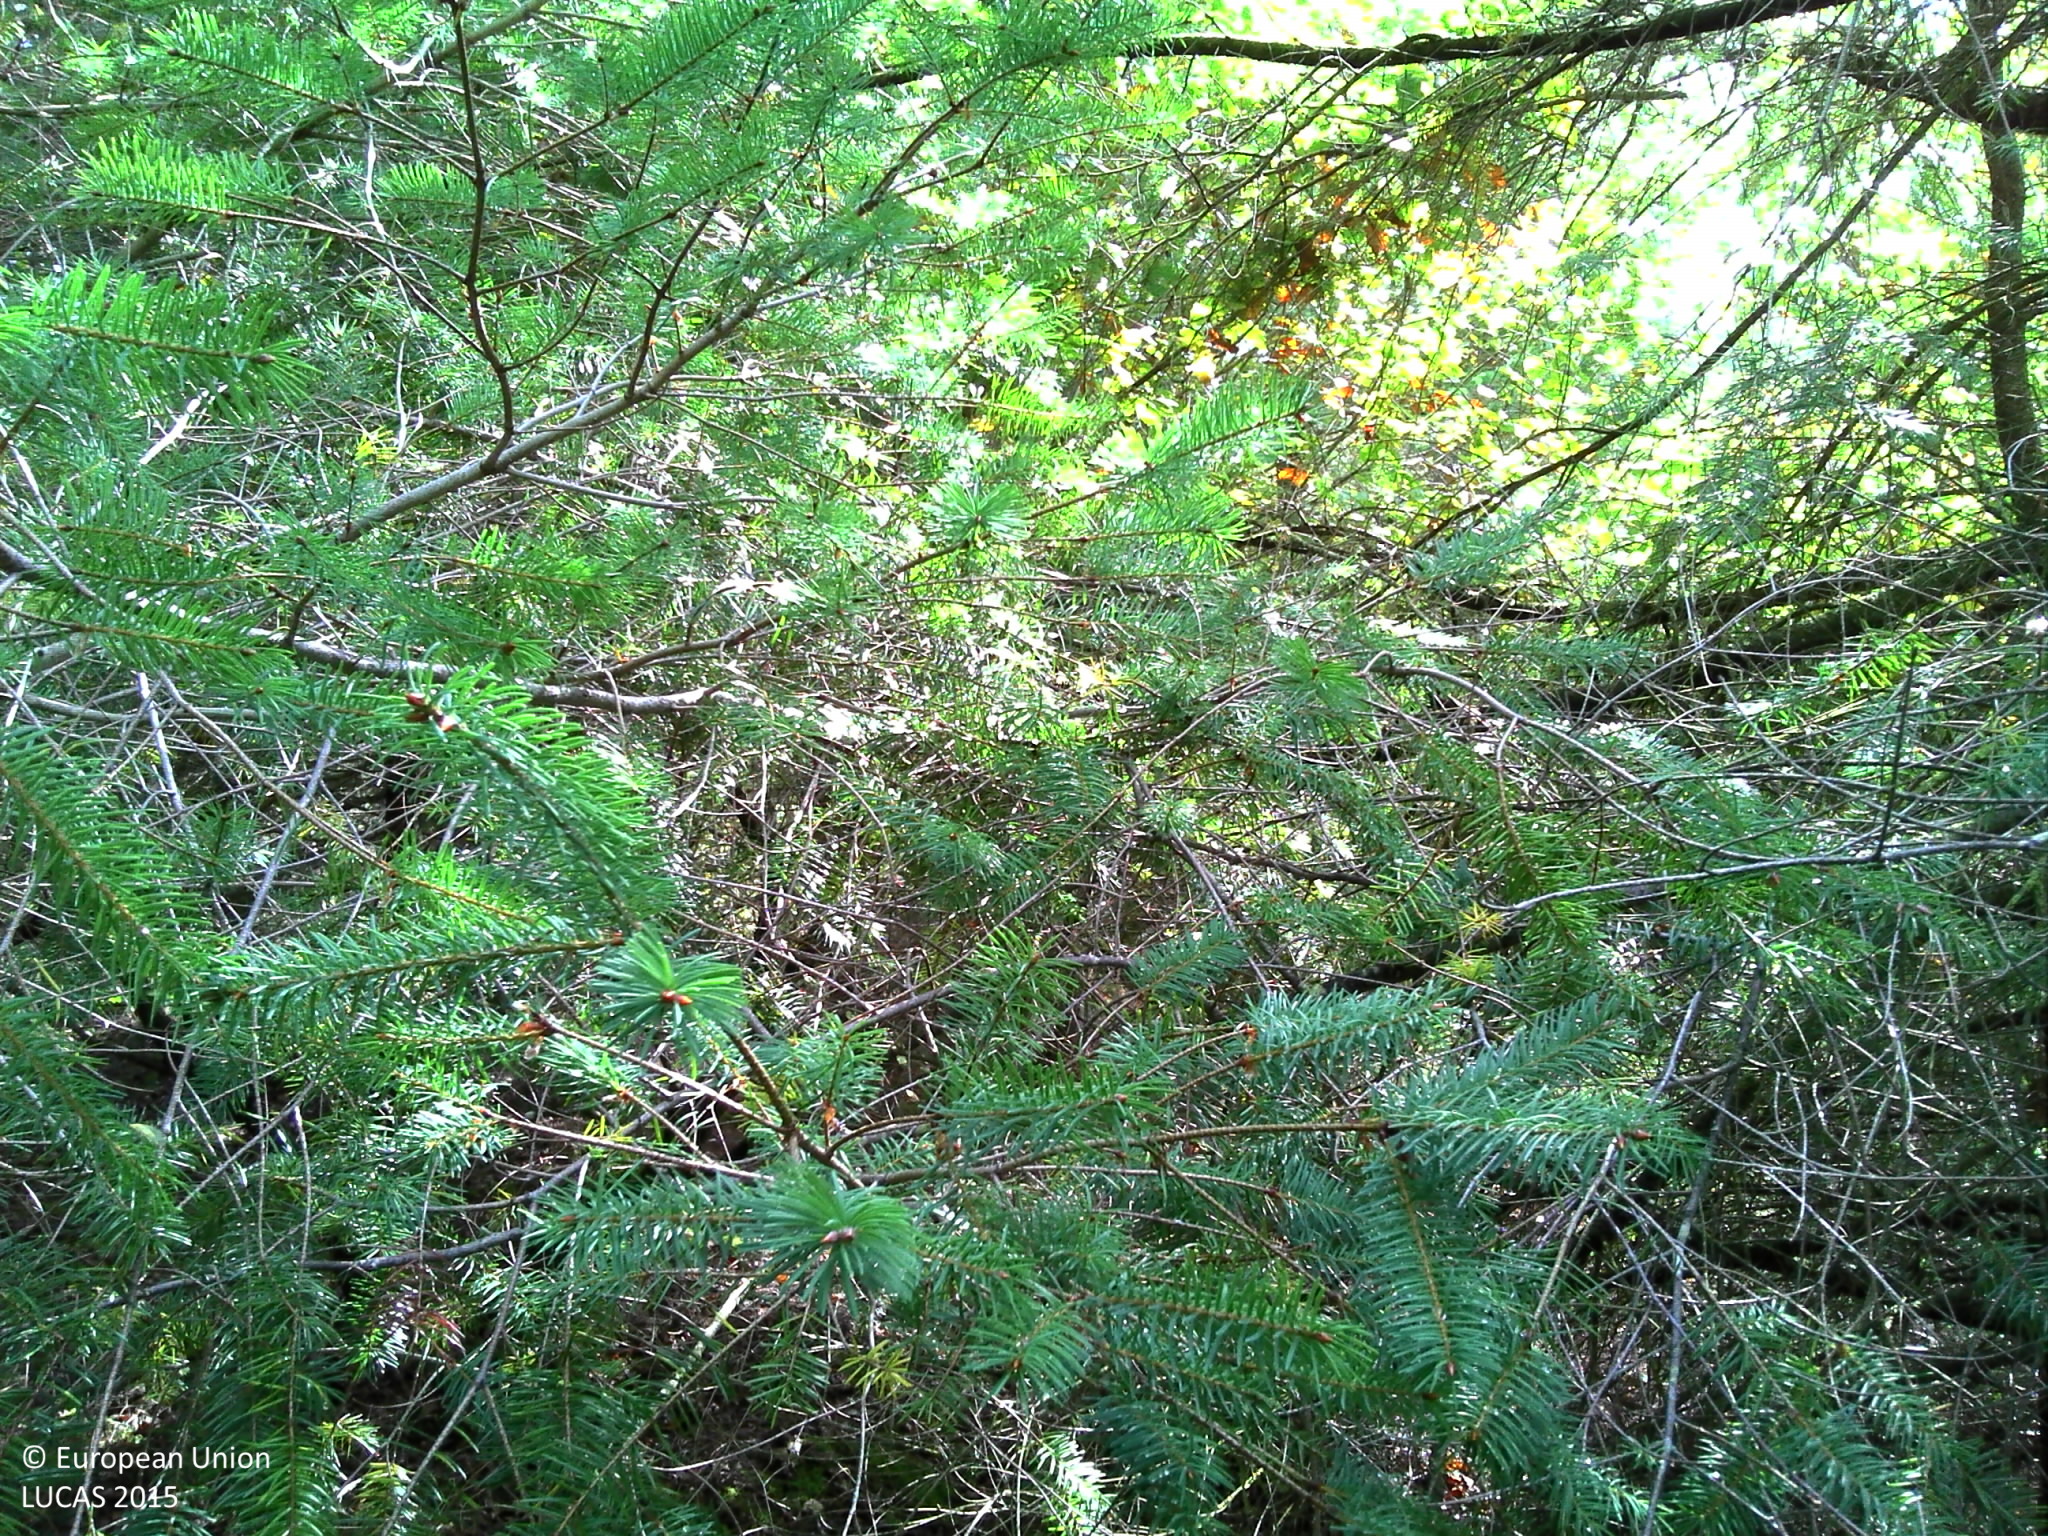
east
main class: Woodland
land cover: Spruce dominated mixed woodland
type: hemiboreal forest and nemoral coniferous forest and mixed broadleaved-coniferous forest
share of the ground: > 75 %
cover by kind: coniferous forest trees 50 %, broadleaved forest trees 30 %, shrubs 15 %, lichens and mosses 5 %
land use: Forestry
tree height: > 5 m
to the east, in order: Spruce dominated mixed woodland; Pine dominated mixed woodland; Broadleaved woodland; Inland fresh running water; Broadleaved woodland; Tracks; Broadleaved woodland; Dry stone walls; Broadleaved woodland; Other bare soil
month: October
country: FR
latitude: 46.0891
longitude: 3.0535
